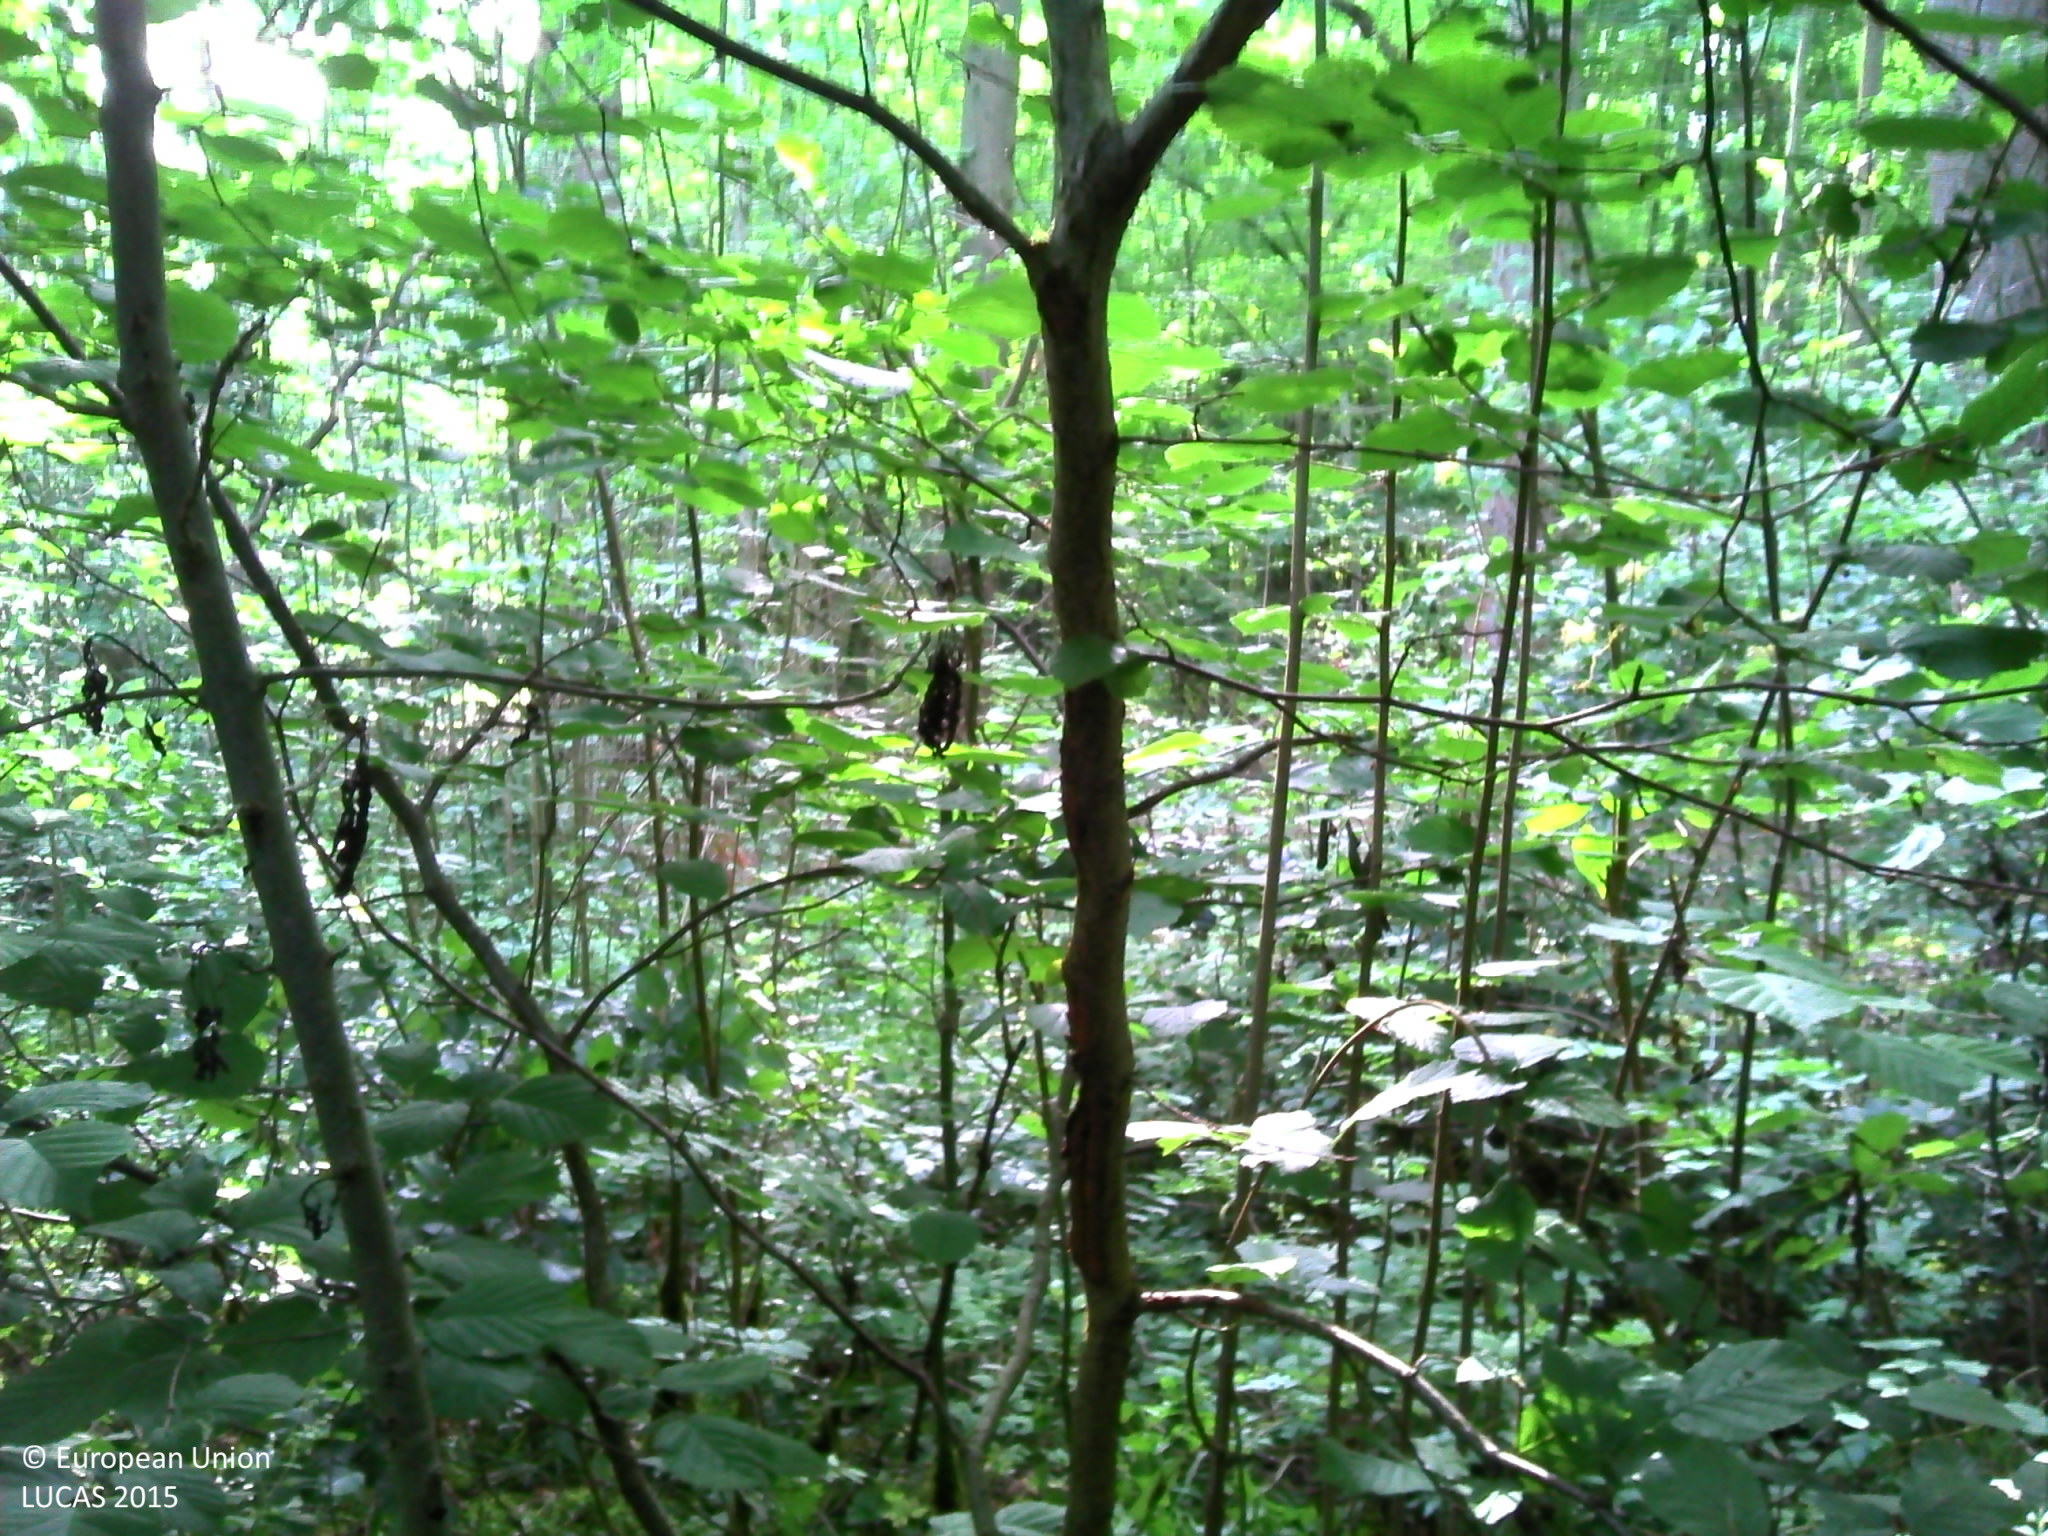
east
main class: Woodland
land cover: Broadleaved woodland
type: mesophytic deciduous forest
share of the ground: > 75 %
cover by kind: broadleaved forest trees 100 %
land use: Forestry
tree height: > 5 m
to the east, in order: Broadleaved woodland; Tracks; Broadleaved woodland; Tracks; Broadleaved woodland; Other coniferous woodland
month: June
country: BE
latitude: 50.1037
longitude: 5.2582
